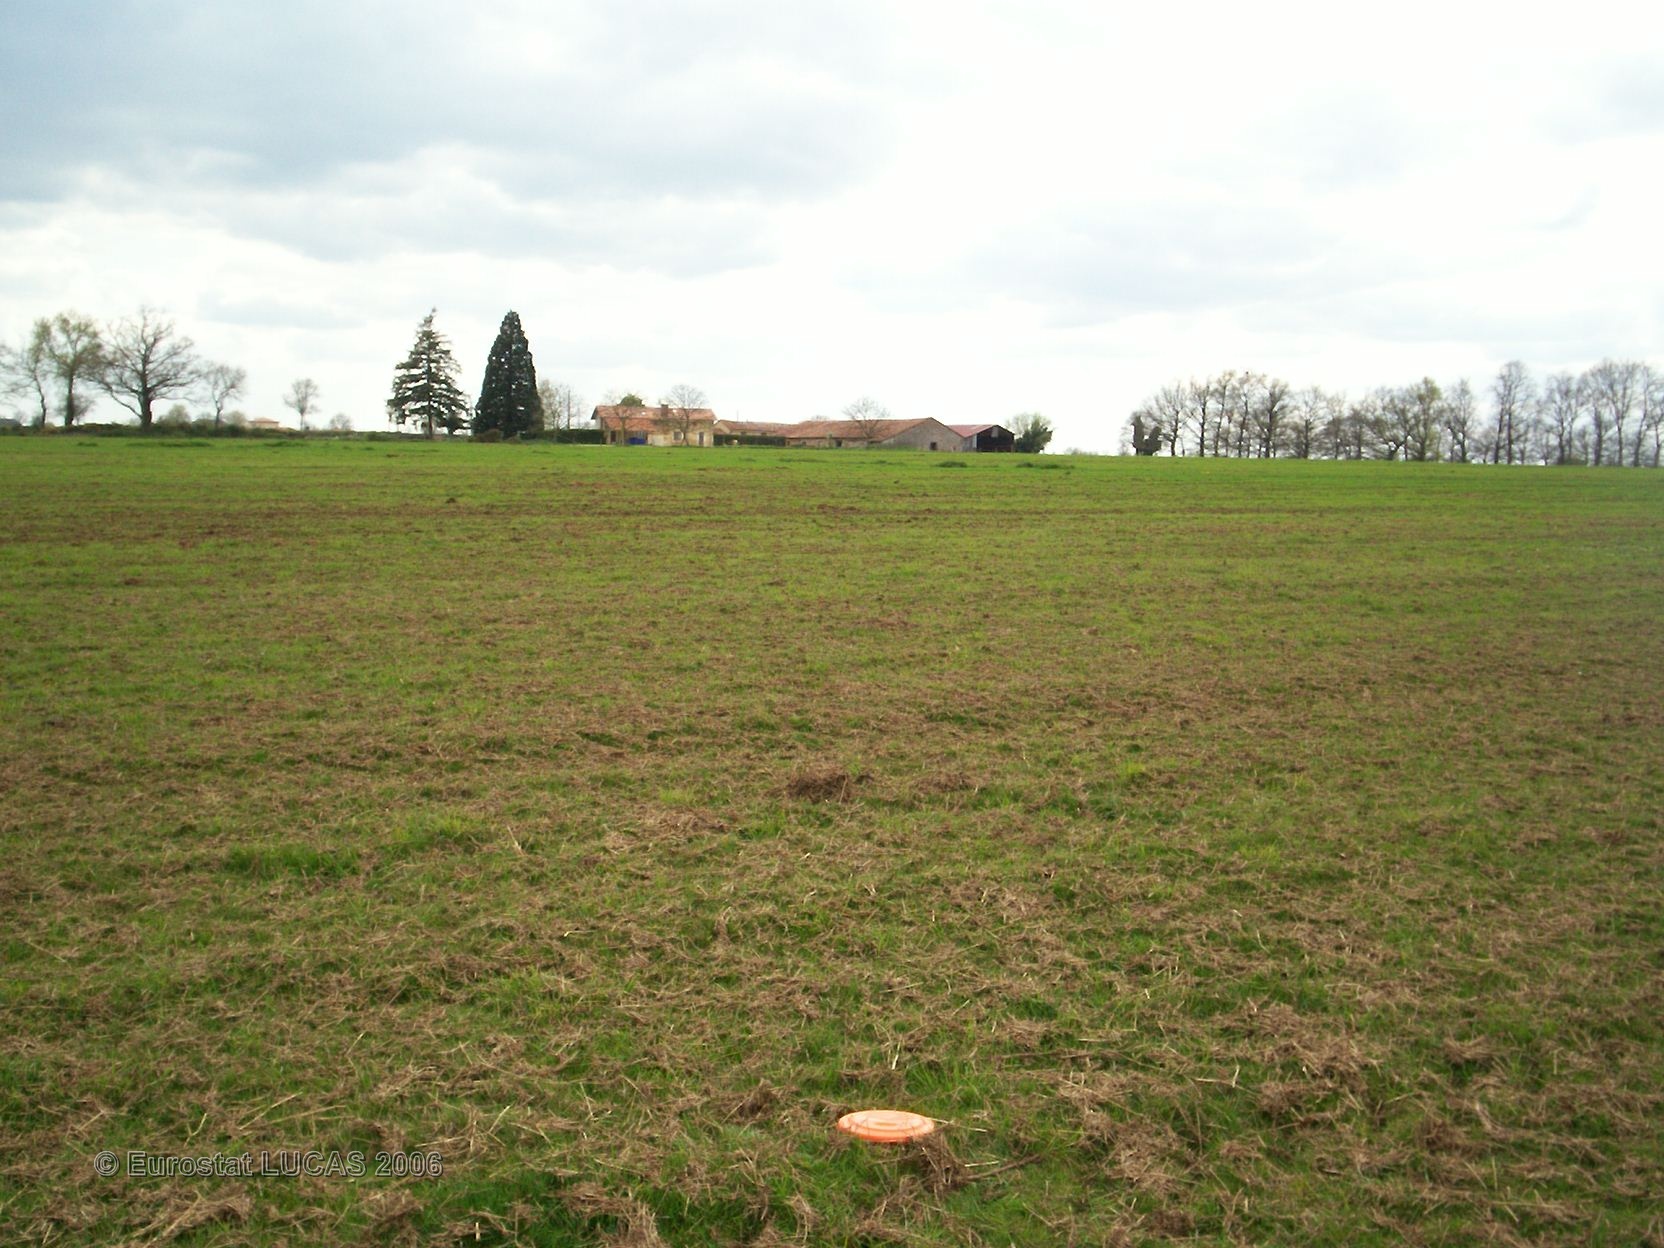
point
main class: Grassland
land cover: Grassland without tree/shrub cover
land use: Agriculture (excluding fallow land and kitchen gardens)
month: April
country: FR
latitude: 46.1135
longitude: 0.5522
